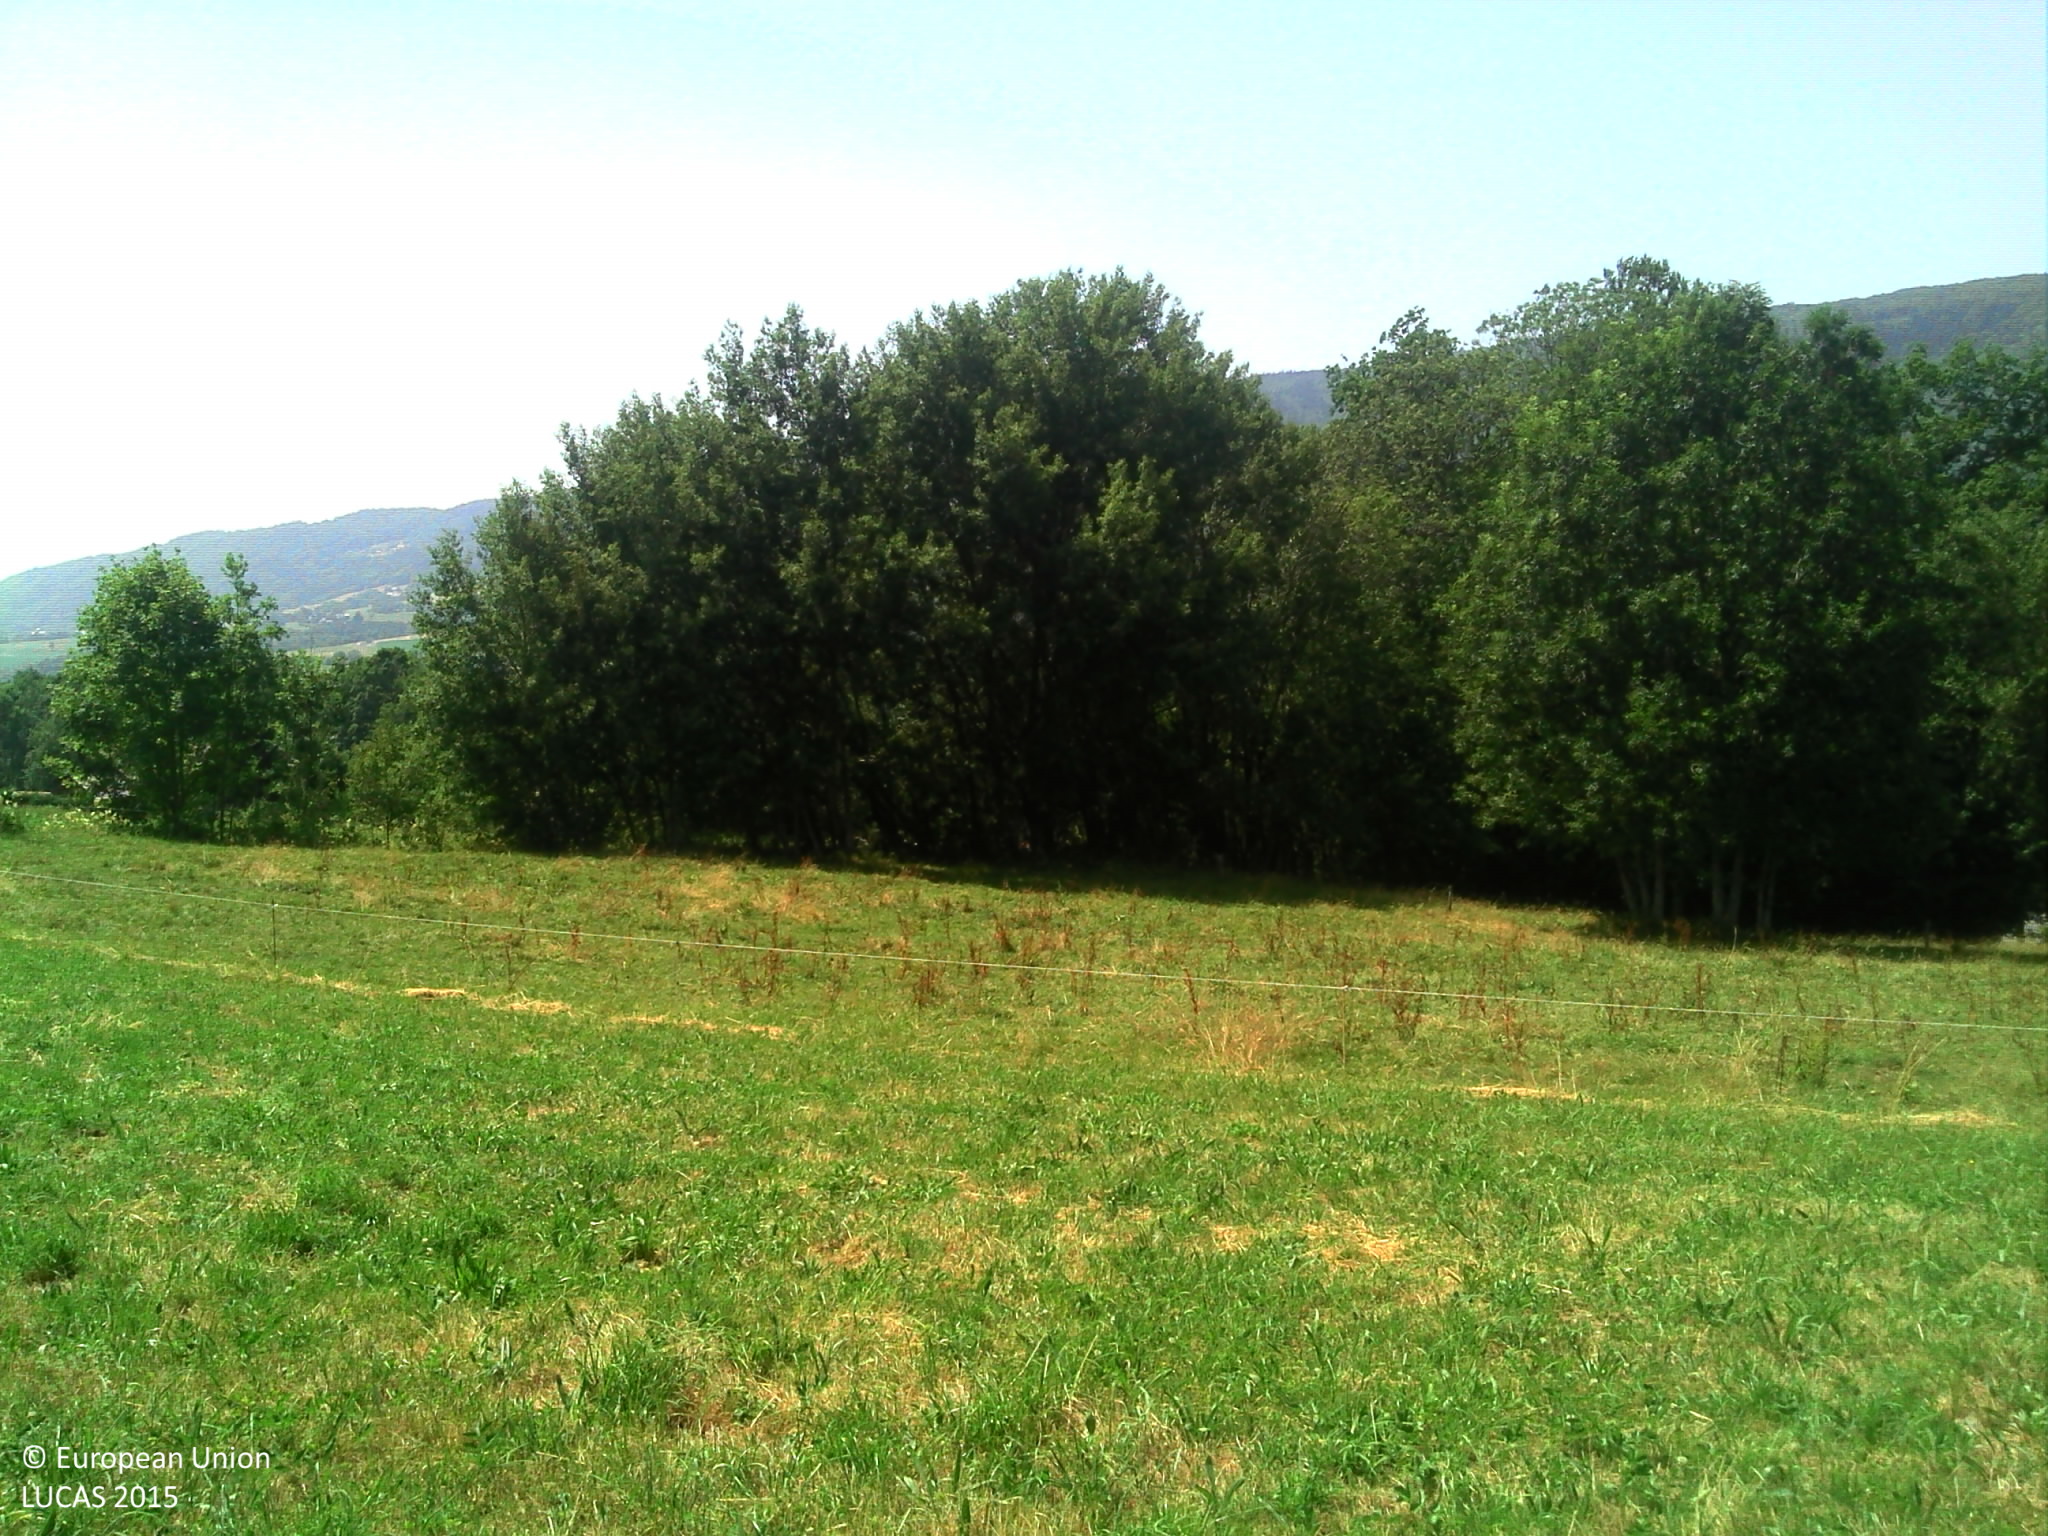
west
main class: Grassland
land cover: Grassland without tree/shrub cover
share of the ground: > 75 %
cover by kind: herbaceous plants 100 %
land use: Agriculture (excluding fallow land and kitchen gardens)
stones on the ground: < 10 %
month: July
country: FR
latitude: 46.0850
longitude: 6.1886
